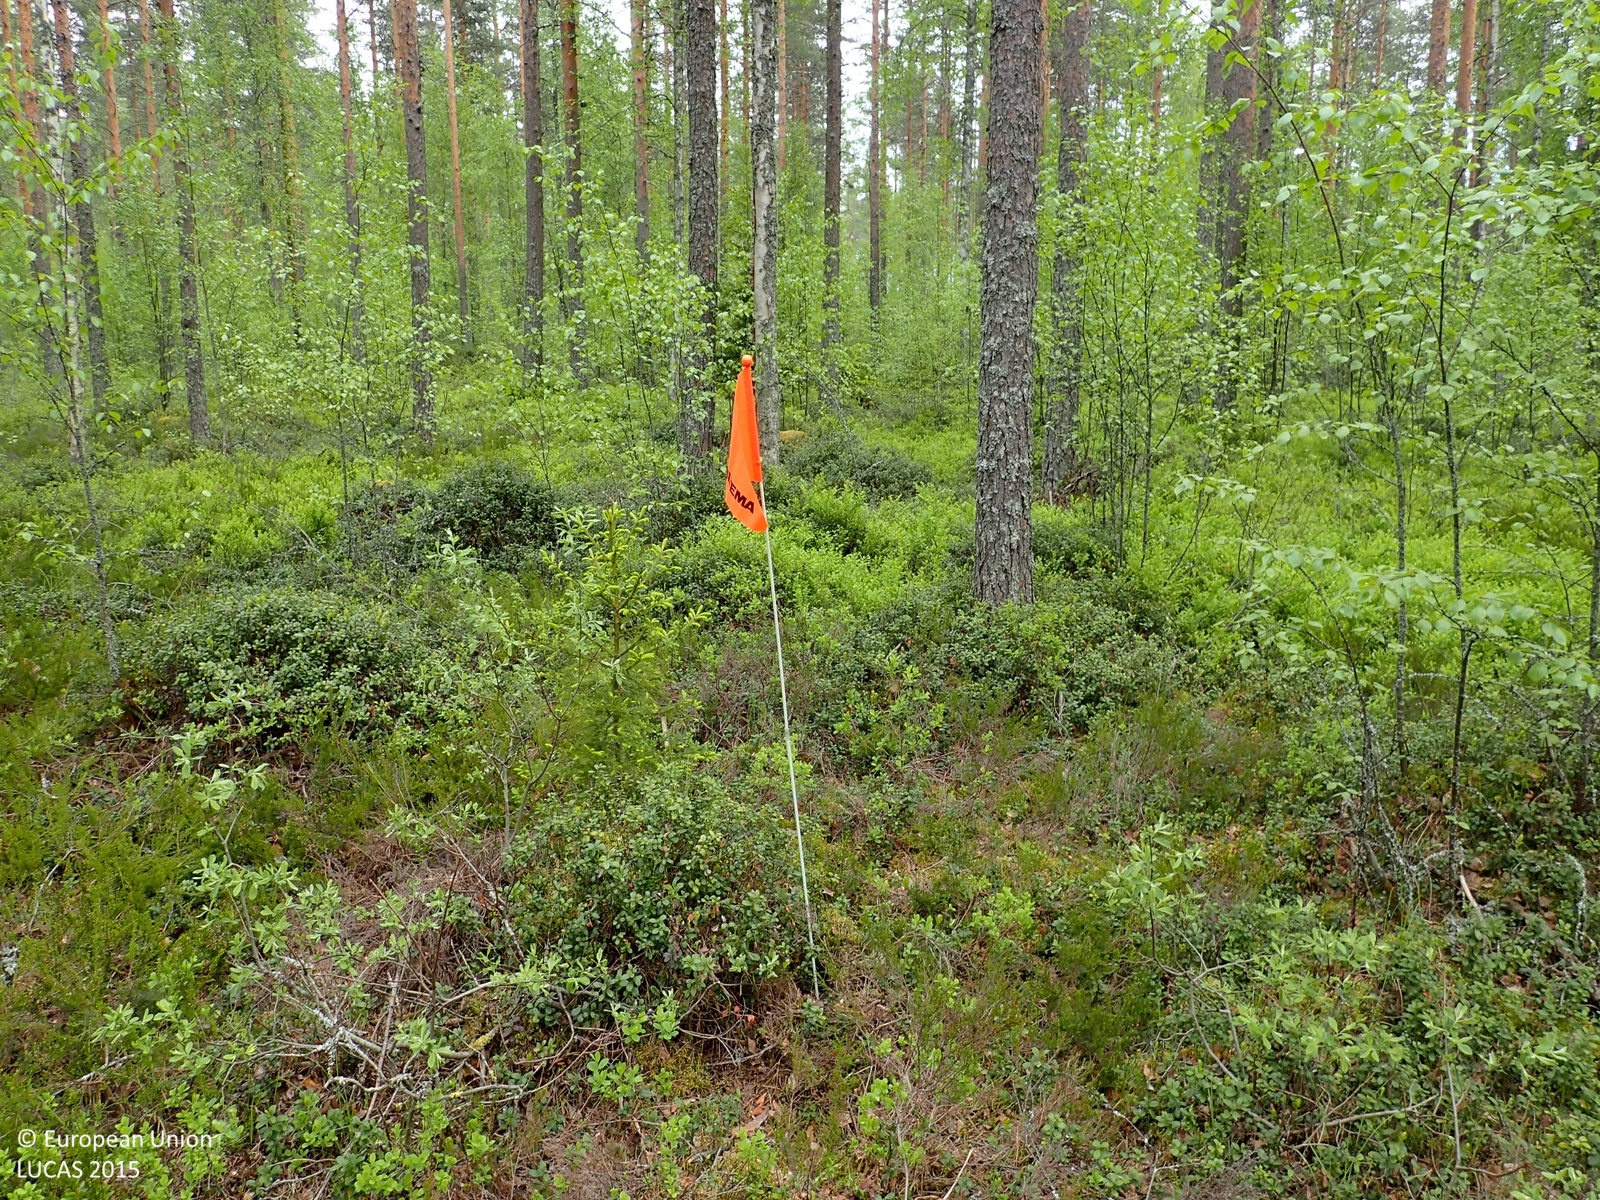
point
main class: Woodland
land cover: Pine dominated mixed woodland
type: boreal forest
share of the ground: 50 - 75 %
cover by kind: shrubs 40 %, coniferous forest trees 30 %, broadleaved forest trees 30 %
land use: Forestry
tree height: > 5 m
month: June
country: FI
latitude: 62.2702
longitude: 22.5220
